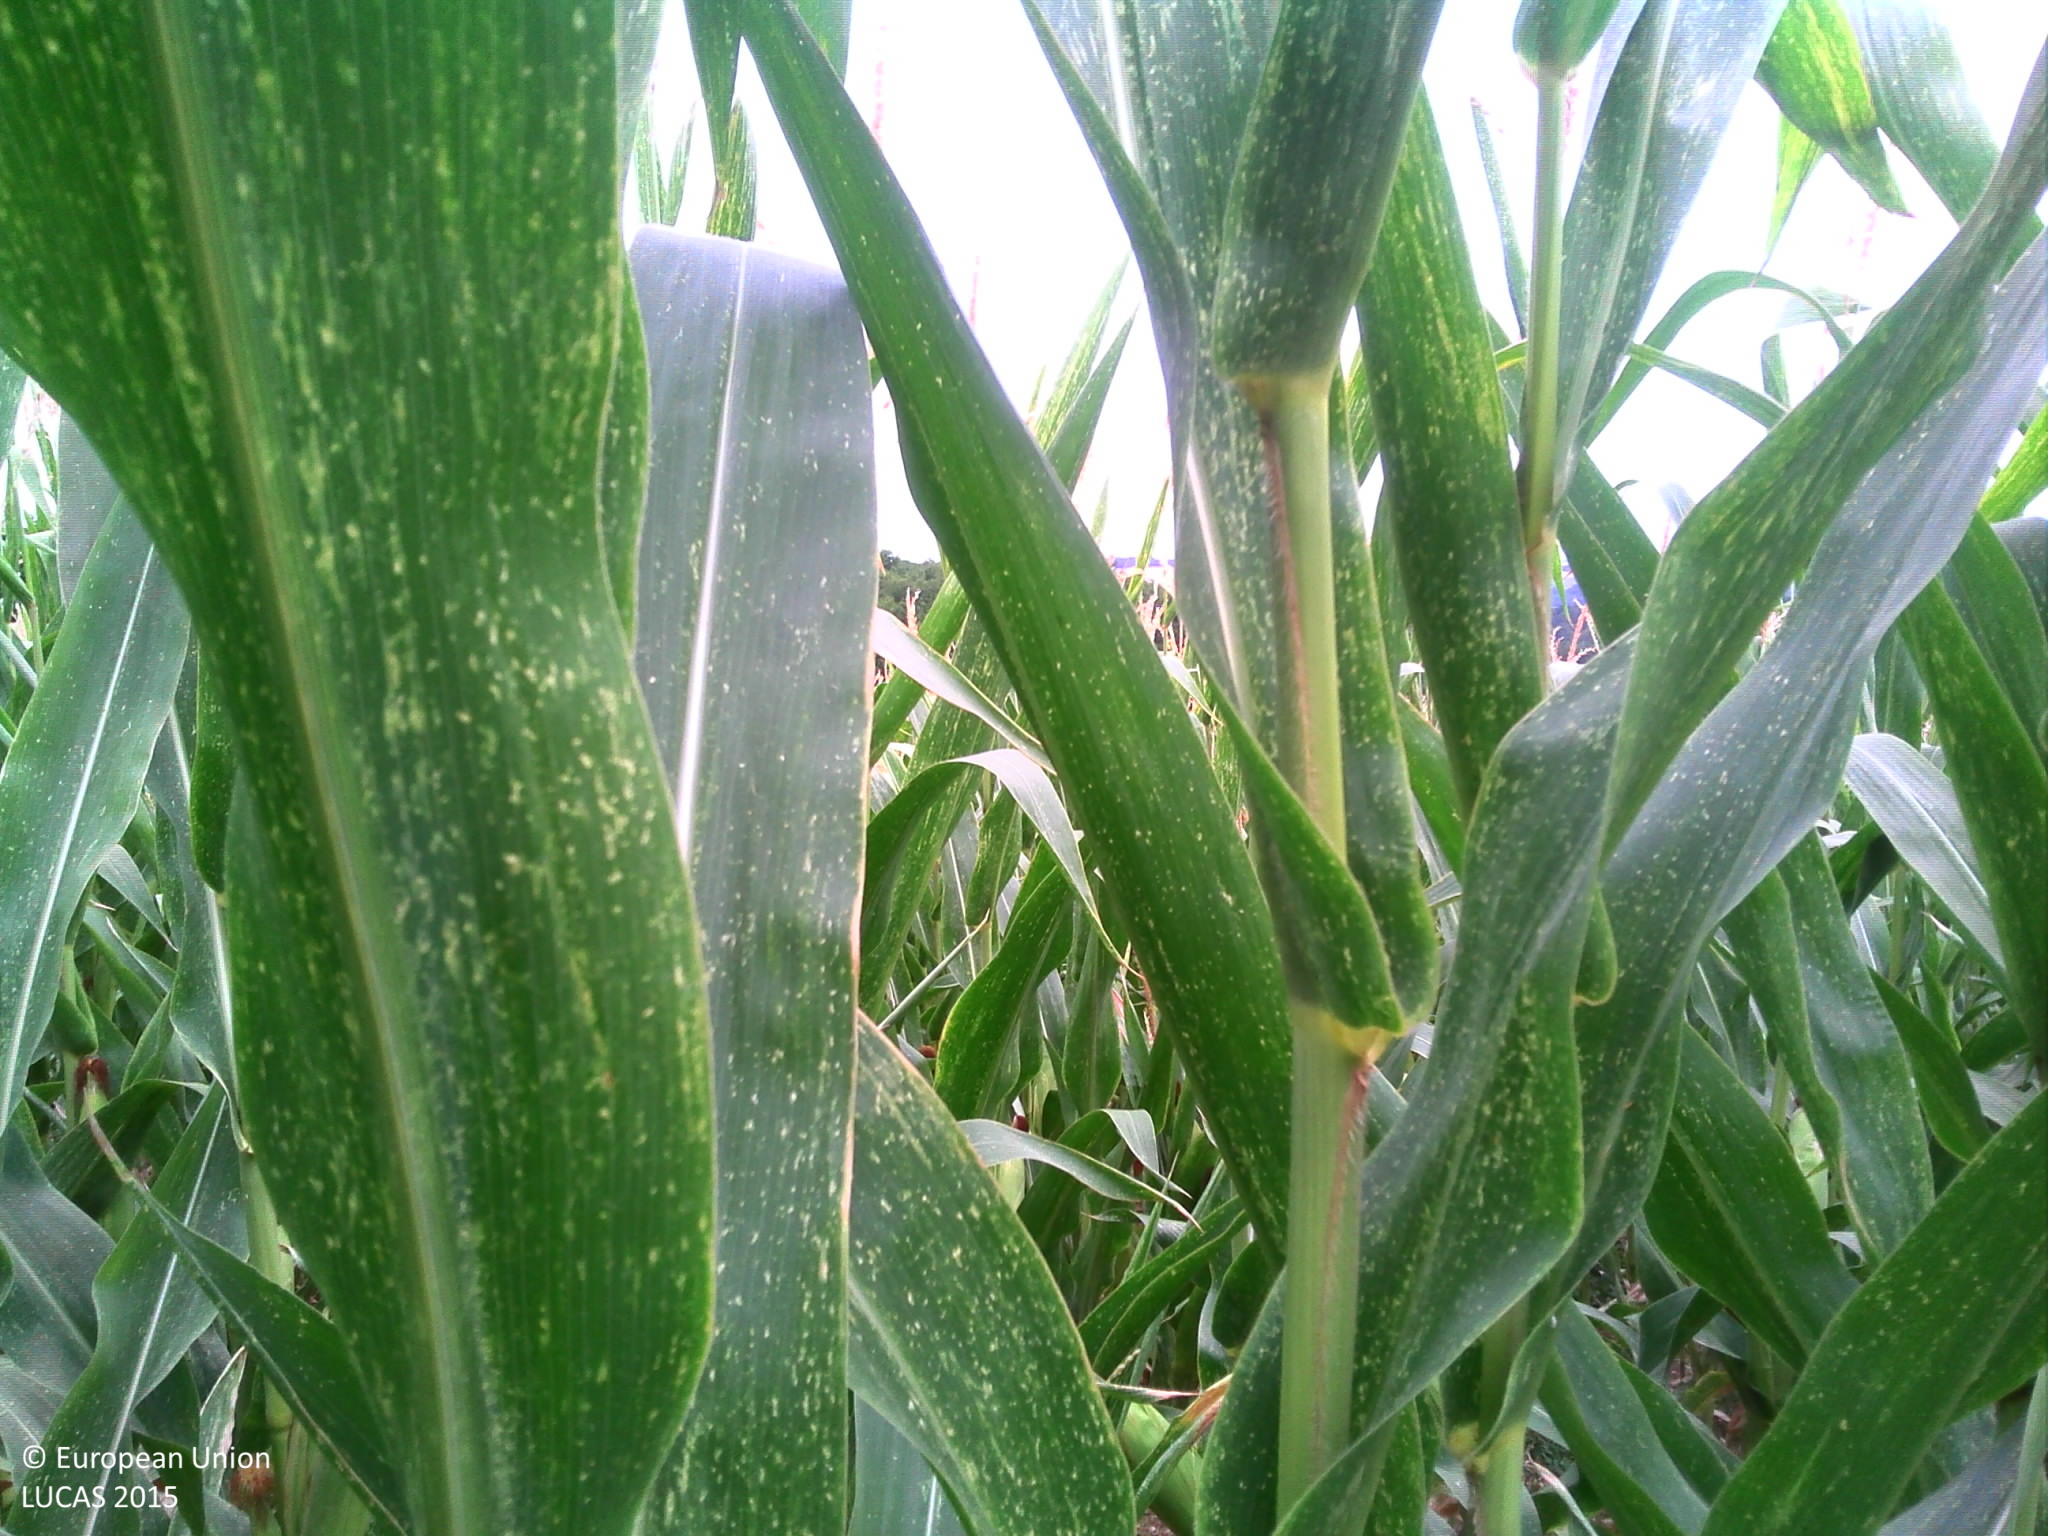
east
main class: Cropland
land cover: Maize
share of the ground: > 75 %
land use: Agriculture (excluding fallow land and kitchen gardens)
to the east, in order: Maize; Paved roads, cycling and walking lanes; Grass margins; Electric lines; Fences; Broadleaved woodland
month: July
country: FR
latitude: 44.0878
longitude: 0.6158
